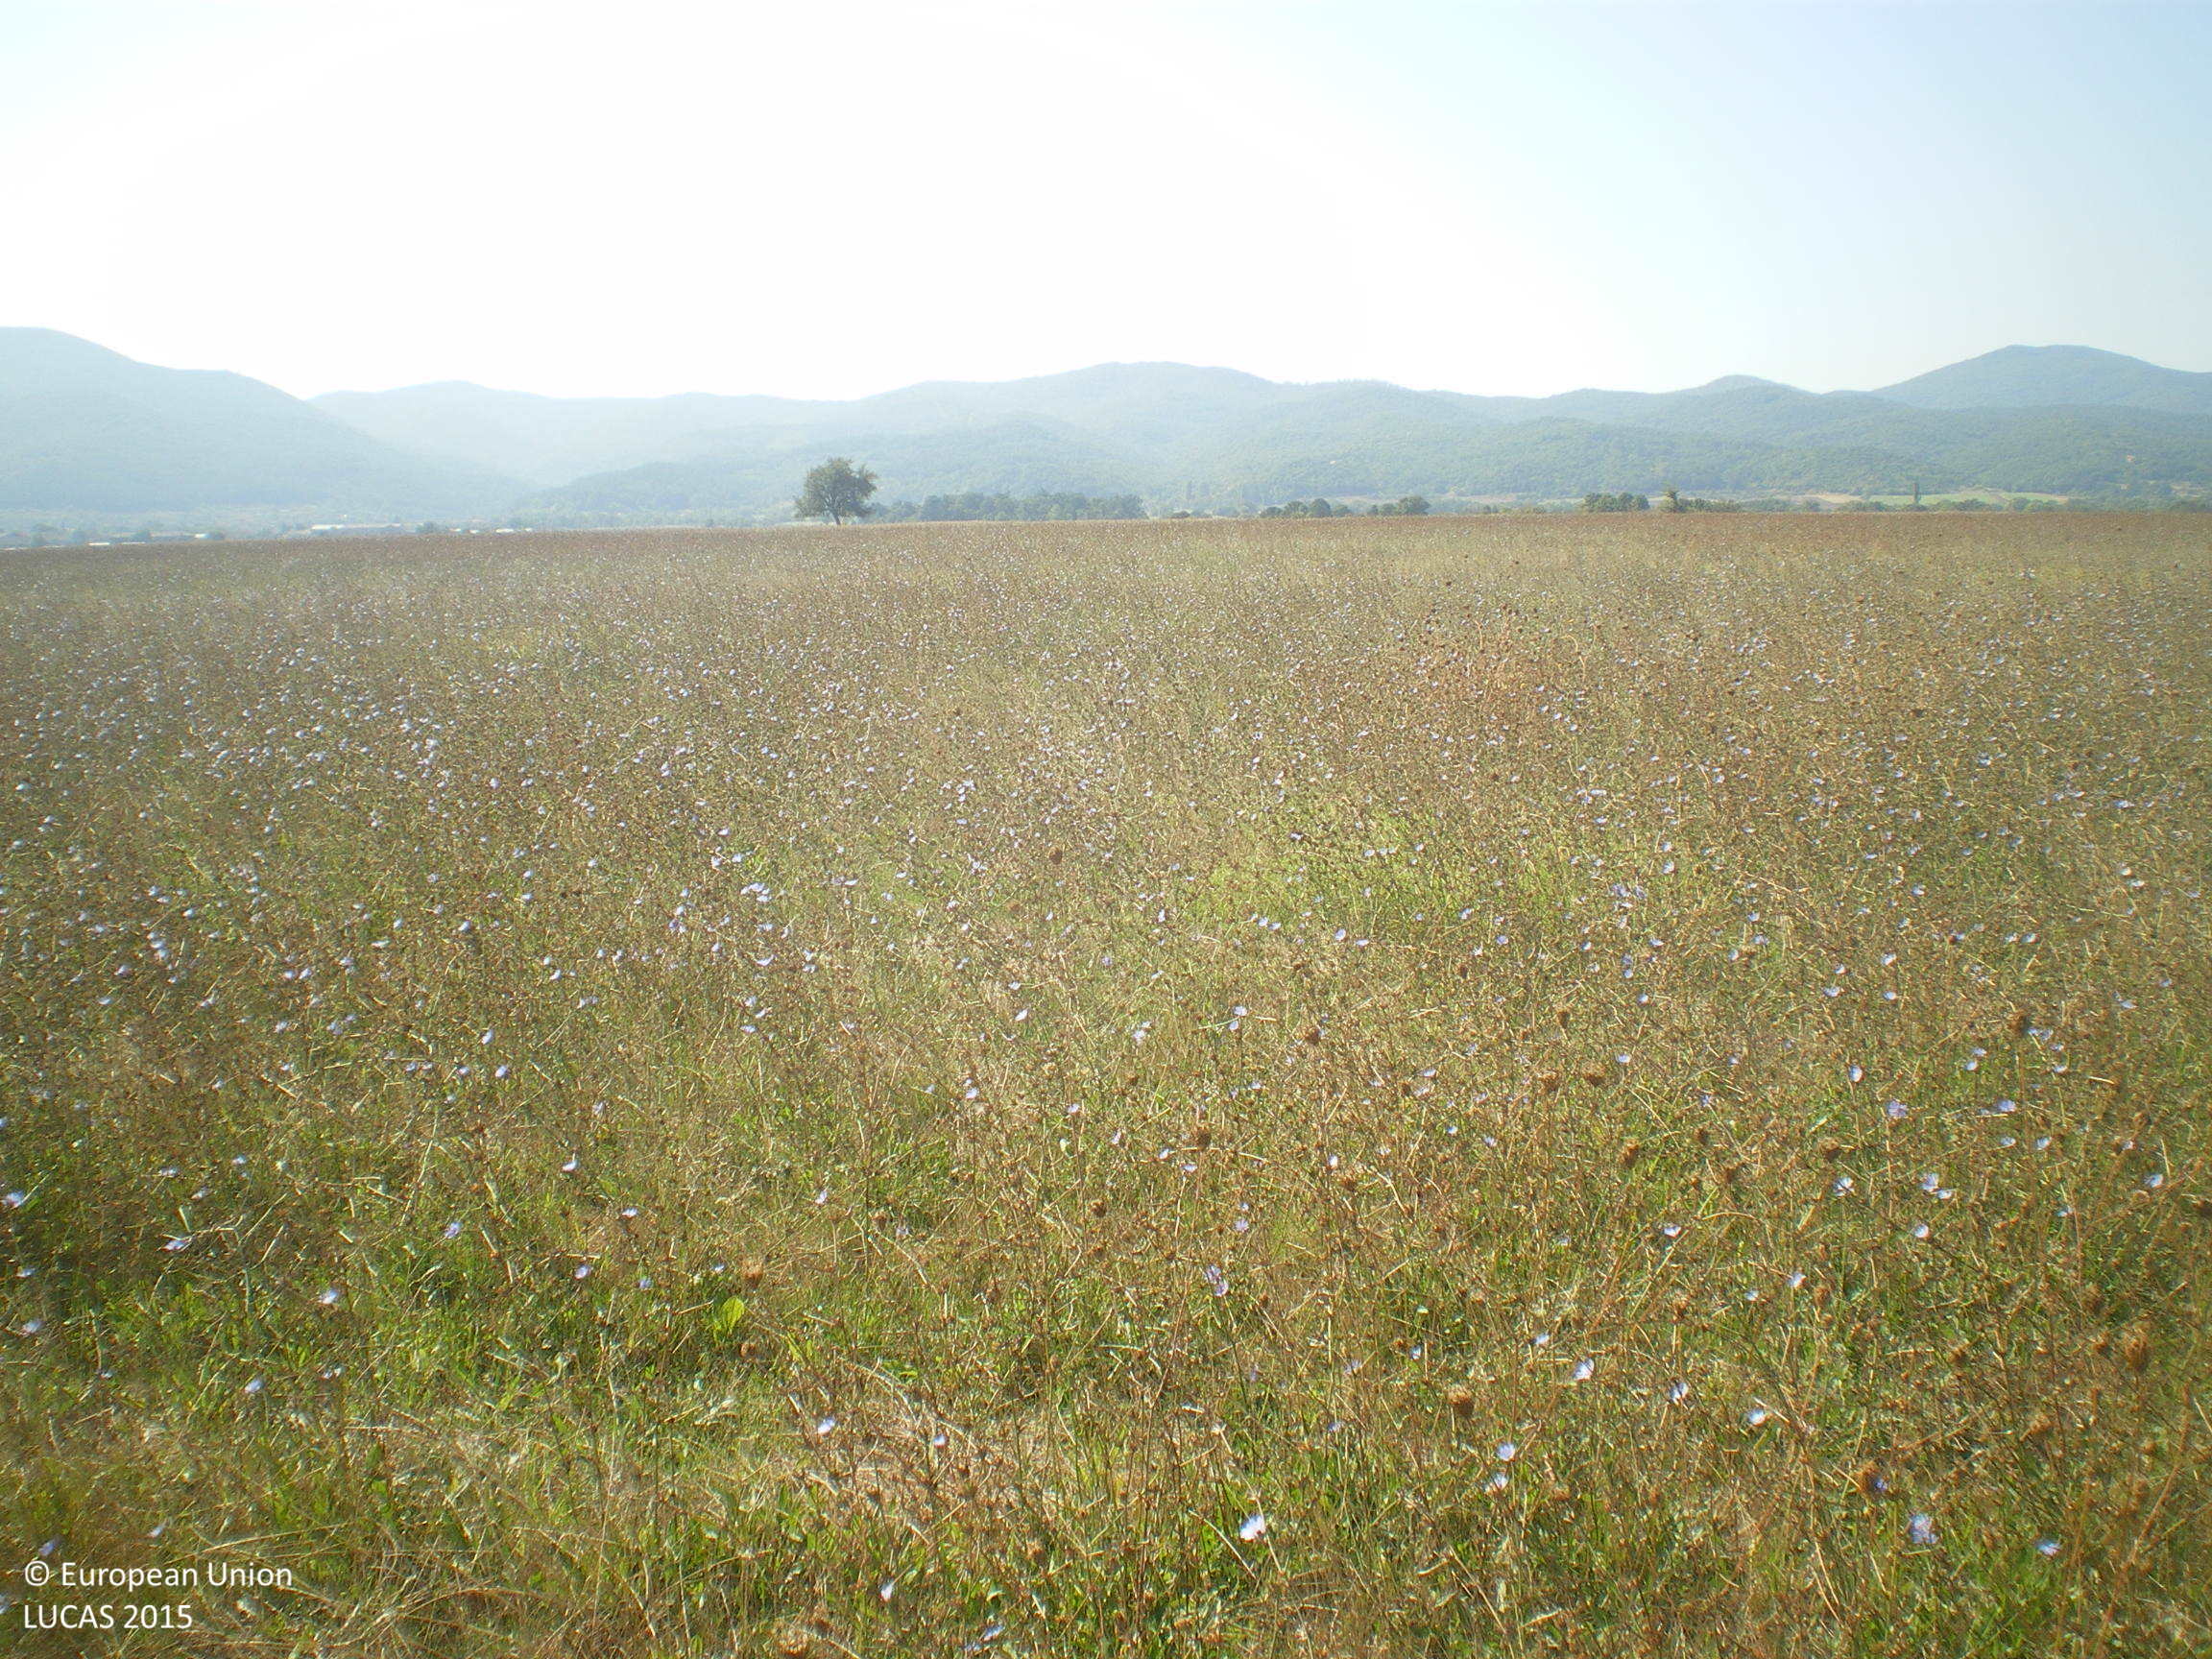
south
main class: Grassland
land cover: Grassland without tree/shrub cover
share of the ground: > 75 %
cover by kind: herbaceous plants 100 %
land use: Agriculture (excluding fallow land and kitchen gardens)
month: September
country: BG
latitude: 41.7786
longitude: 25.9885
